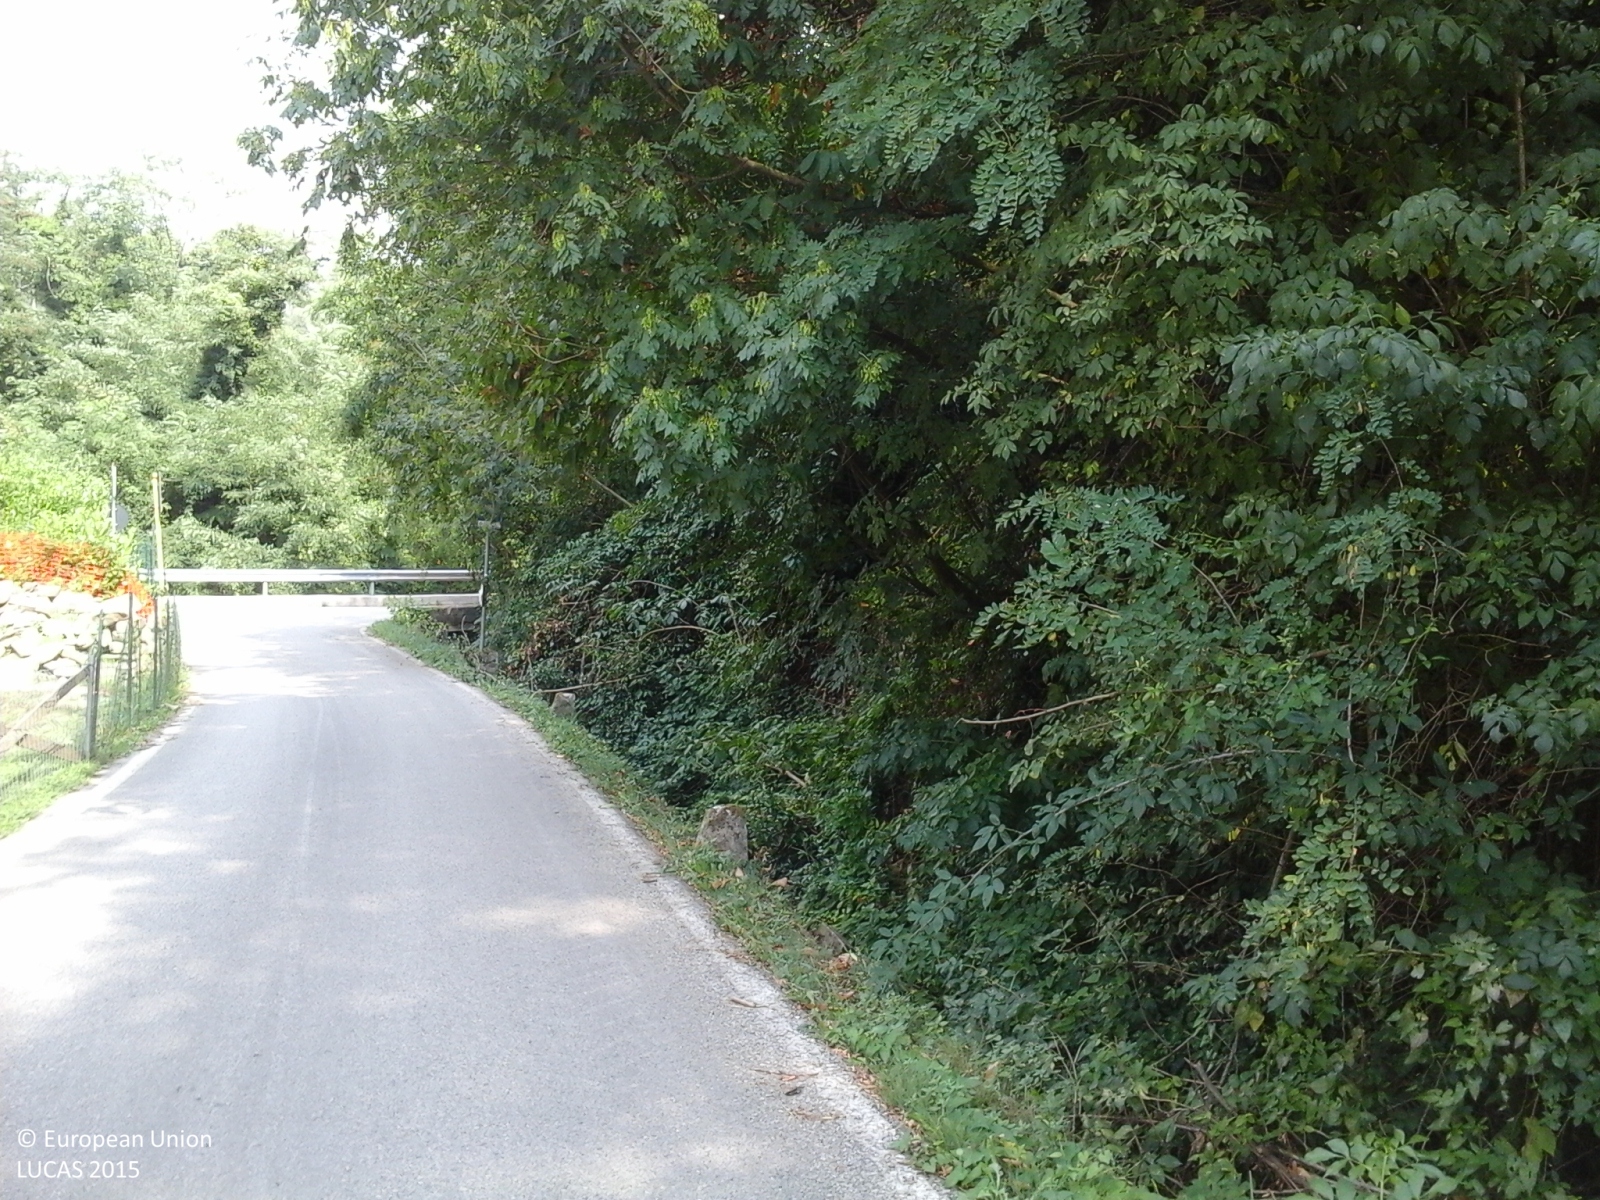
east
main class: Grassland
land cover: Grassland without tree/shrub cover
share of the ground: 50 - 75 %
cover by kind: herbaceous plants 95 %, shrubs 5 %
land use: Residential
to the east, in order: Grassland without tree/shrub cover; Fences; Paved roads, cycling and walking lanes; Inland fresh running water; Broadleaved woodland; Grassland without tree/shrub cover; Electric lines; Olive groves; Grassland without tree/shrub cover
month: August
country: IT
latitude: 43.9501
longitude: 10.8576
